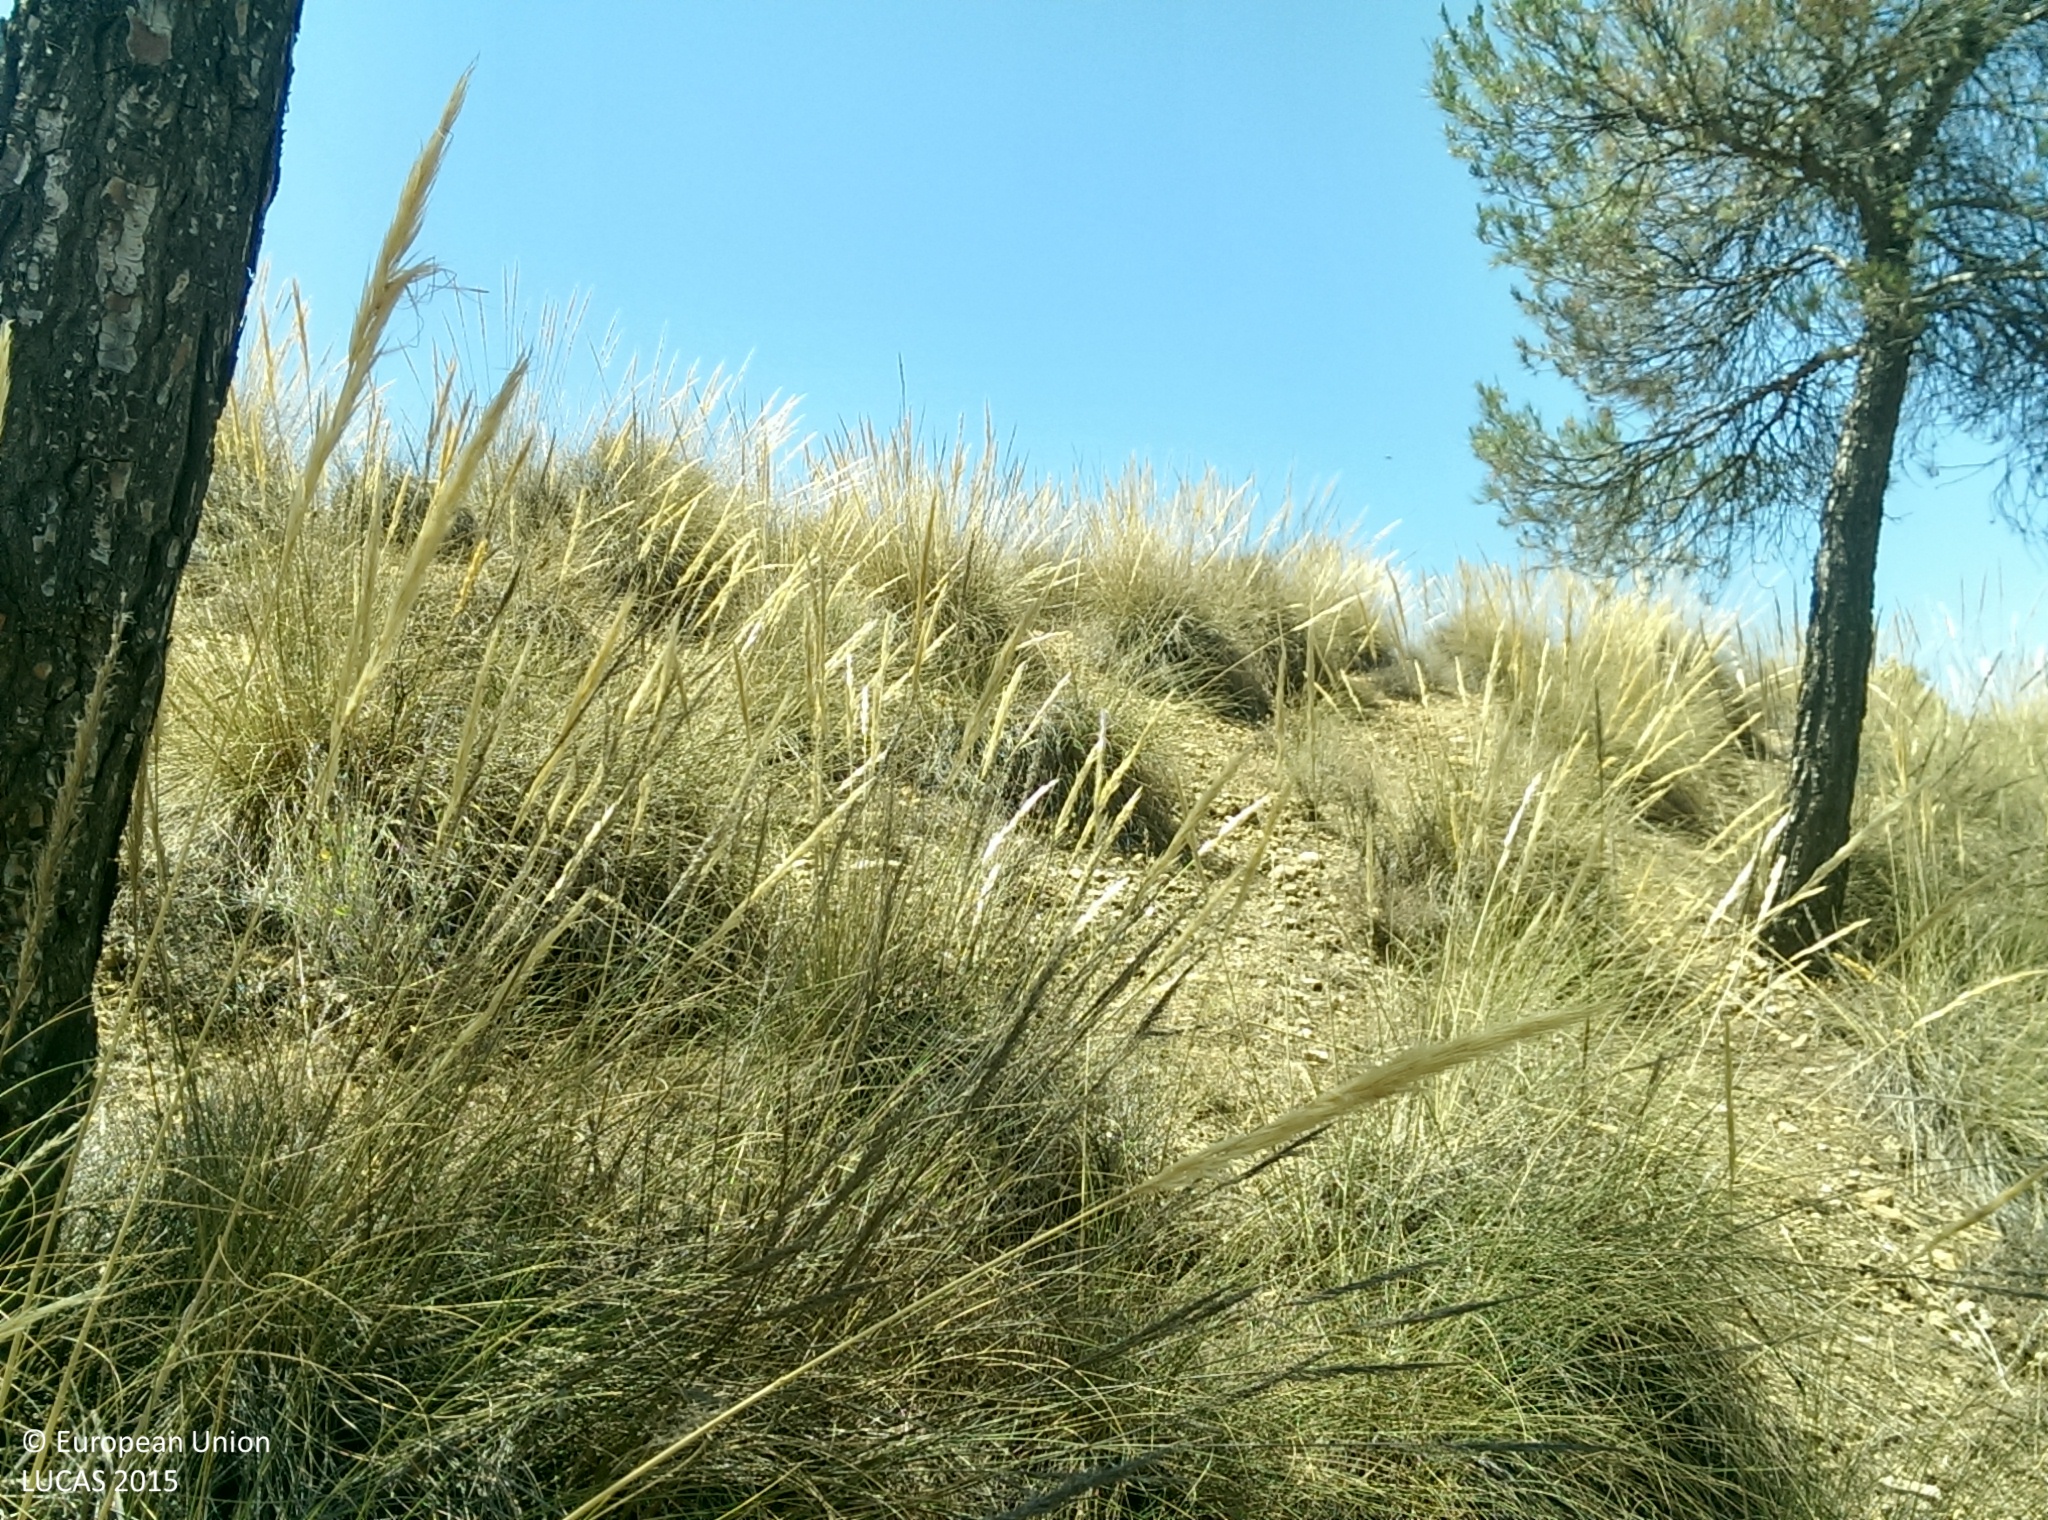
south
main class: Woodland
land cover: Pine dominated coniferous woodland
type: coniferous forest of the mediterranean region
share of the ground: 50 - 75 %
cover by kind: coniferous forest trees 60 %, herbaceous plants 25 %, shrubs 10 %, unconsolidated bare surface 5 %
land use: Forestry
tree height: > 5 m
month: July
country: ES
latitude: 37.3128
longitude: -3.1096
